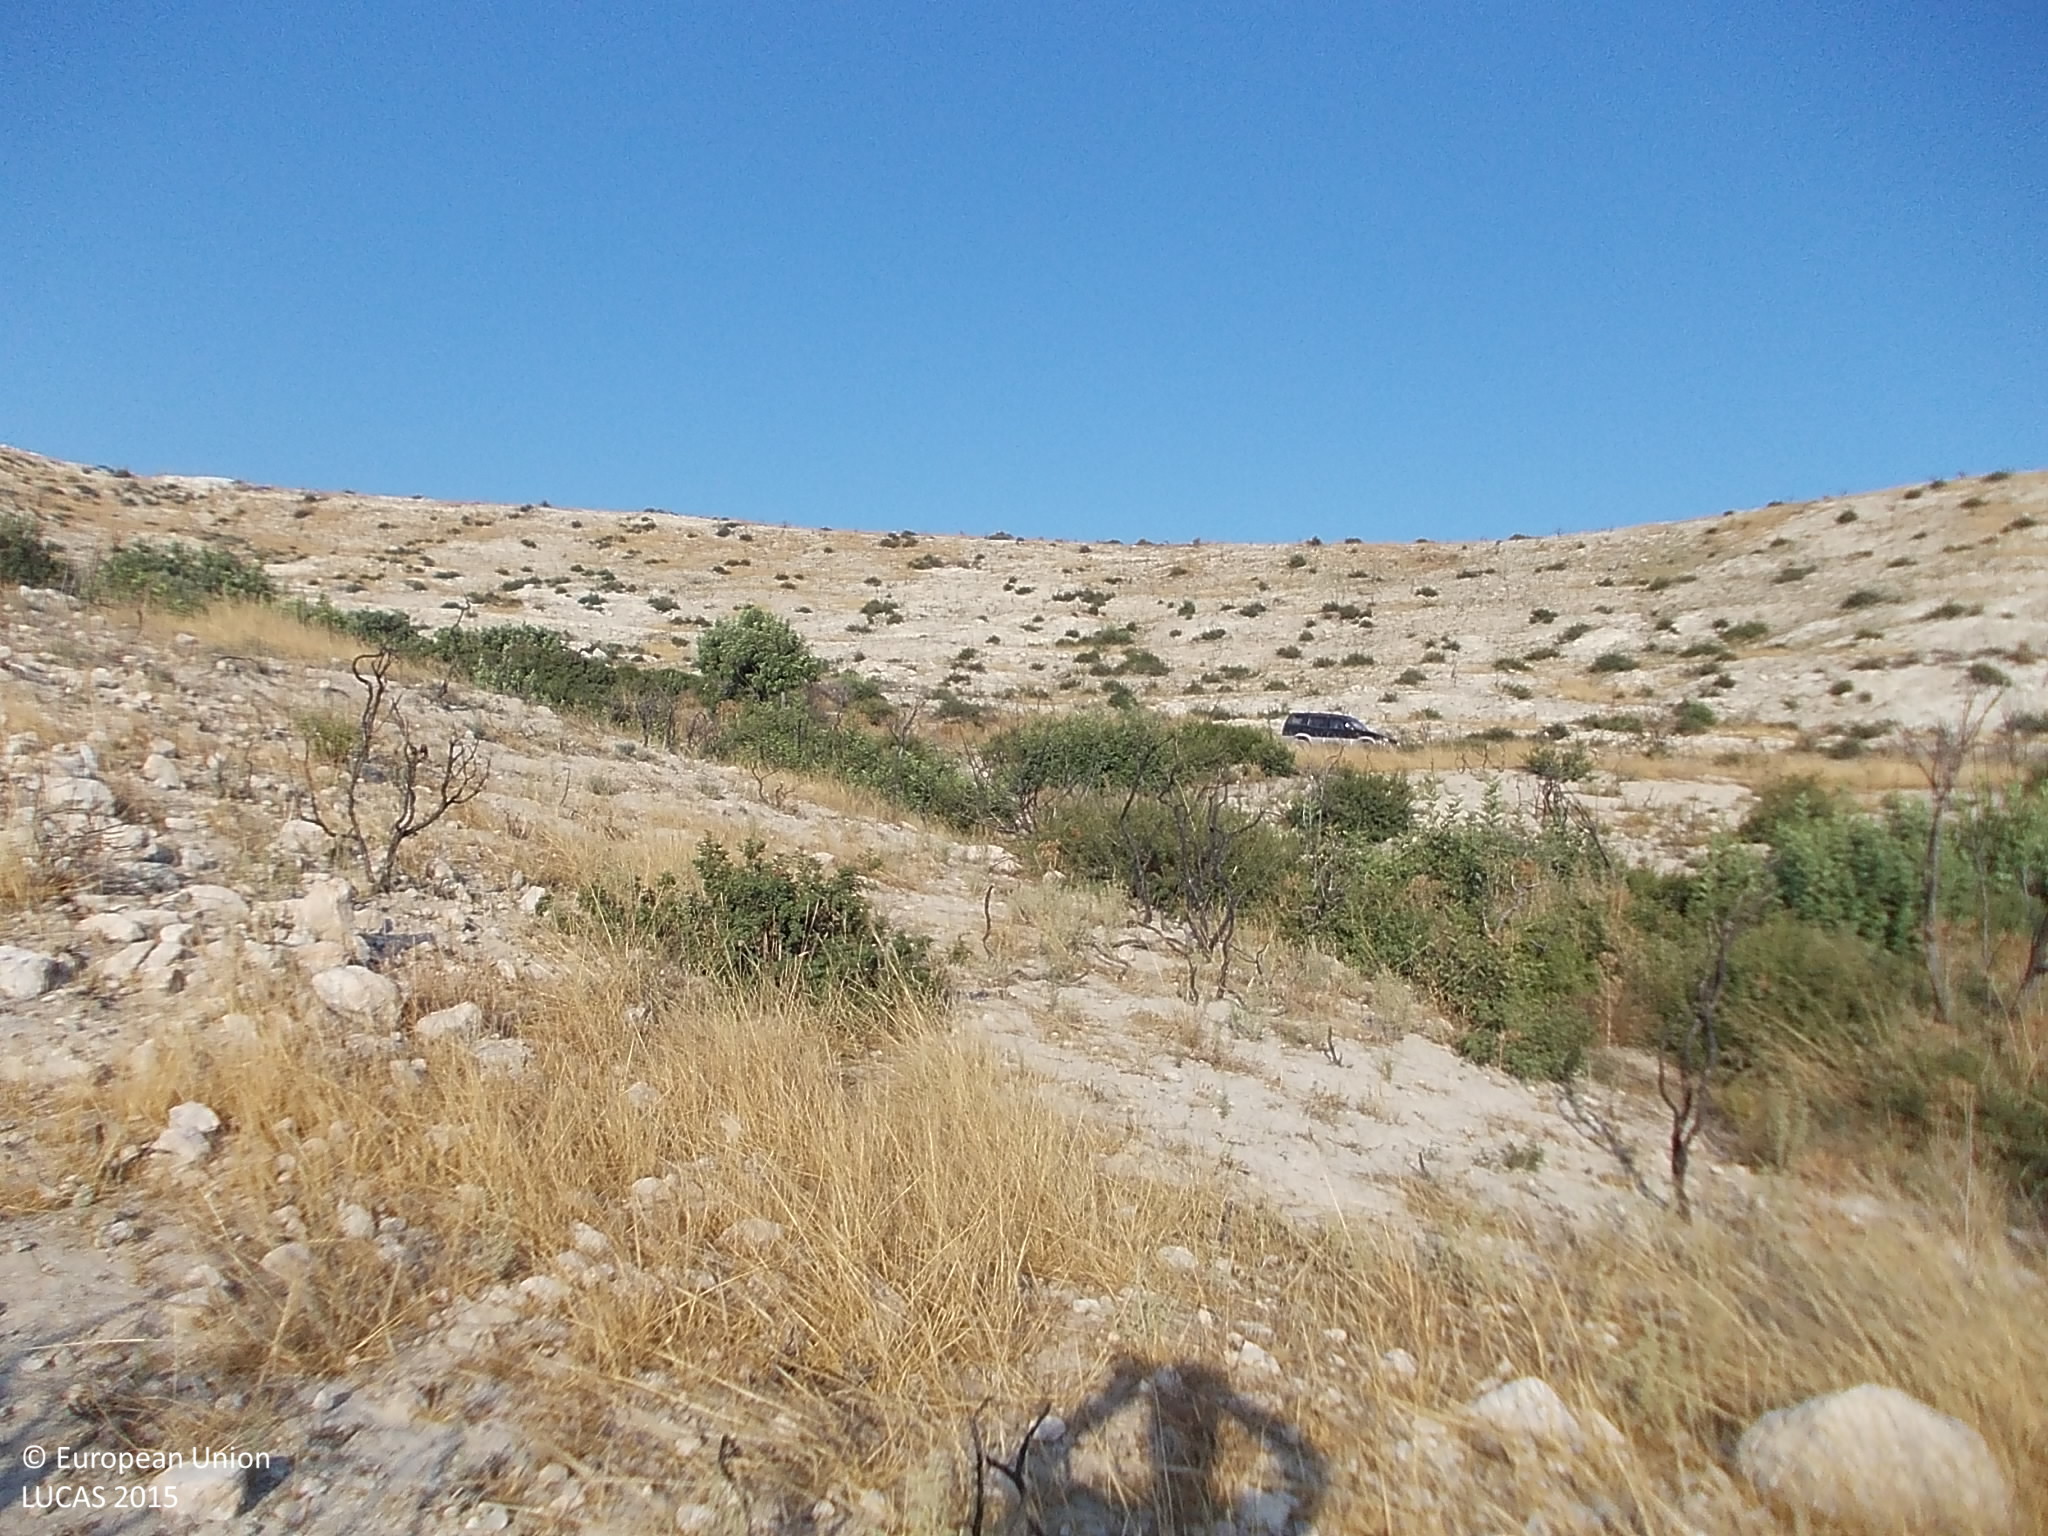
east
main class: Shrubland
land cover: Shrubland without tree cover
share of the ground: 10 - 25 %
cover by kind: unconsolidated bare surface 70 %, herbaceous plants 20 %, shrubs 10 %
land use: Semi-natural and natural areas not in use
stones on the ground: 10 - 25 %
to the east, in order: Shrubland without tree cover; Tracks; Shrubland without tree cover
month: August
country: CY
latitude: 34.6944
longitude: 32.8757
